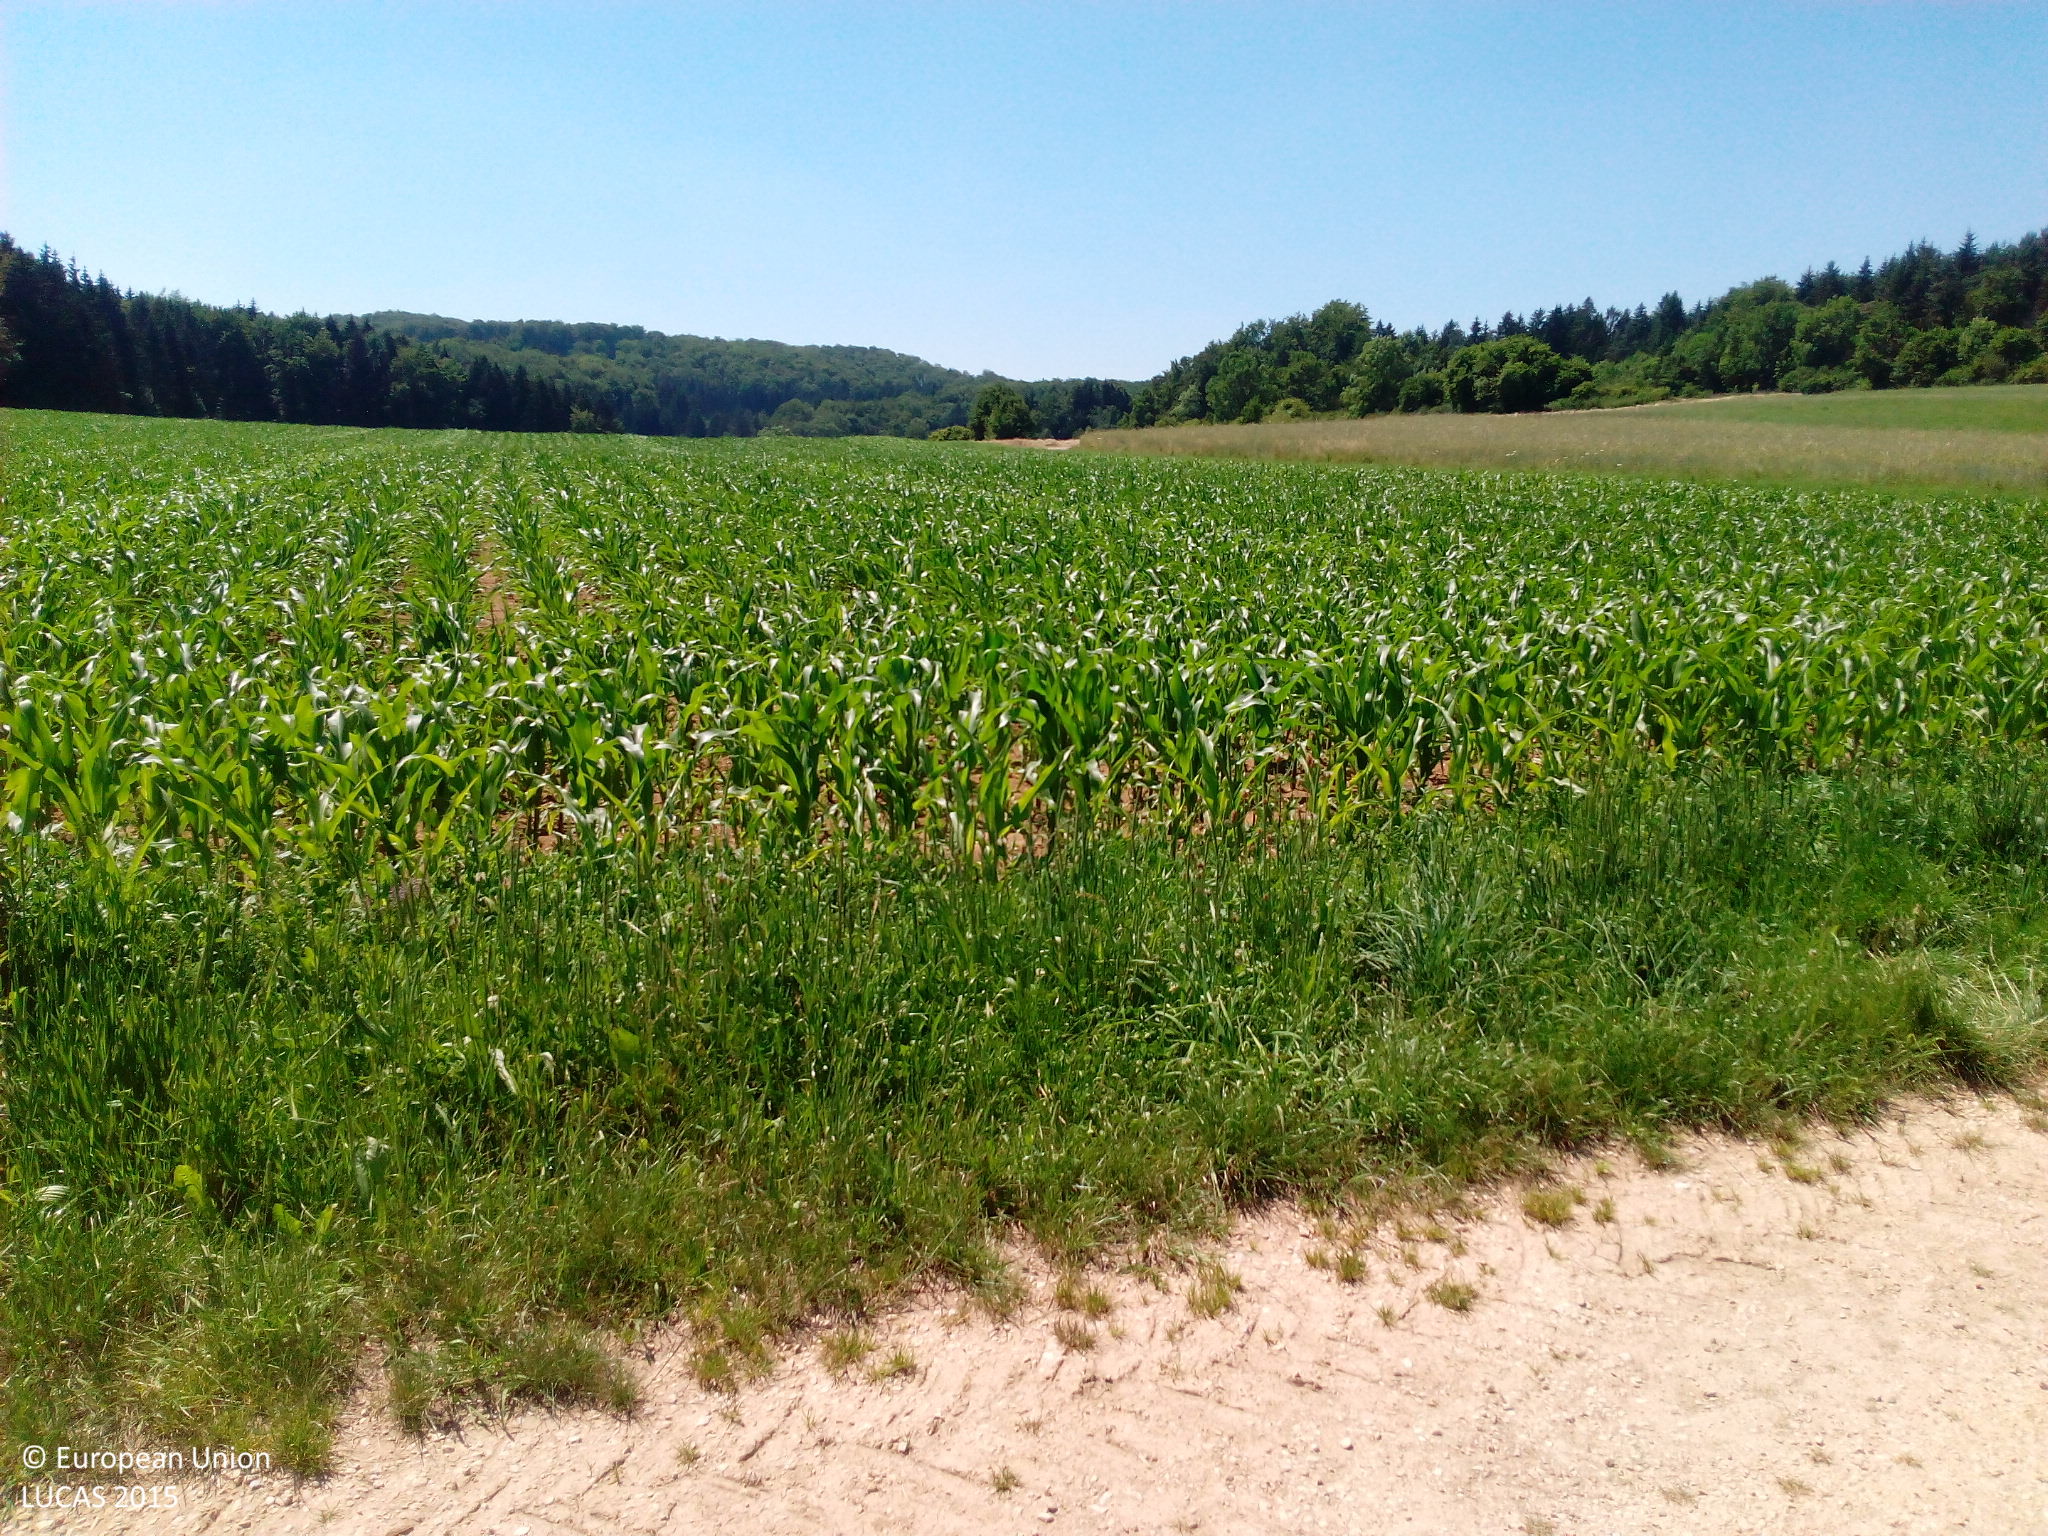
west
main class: Cropland
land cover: Rape and turnip rape
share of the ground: > 75 %
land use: Agriculture (excluding fallow land and kitchen gardens)
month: July
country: DE
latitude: 48.3120
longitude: 9.4205
